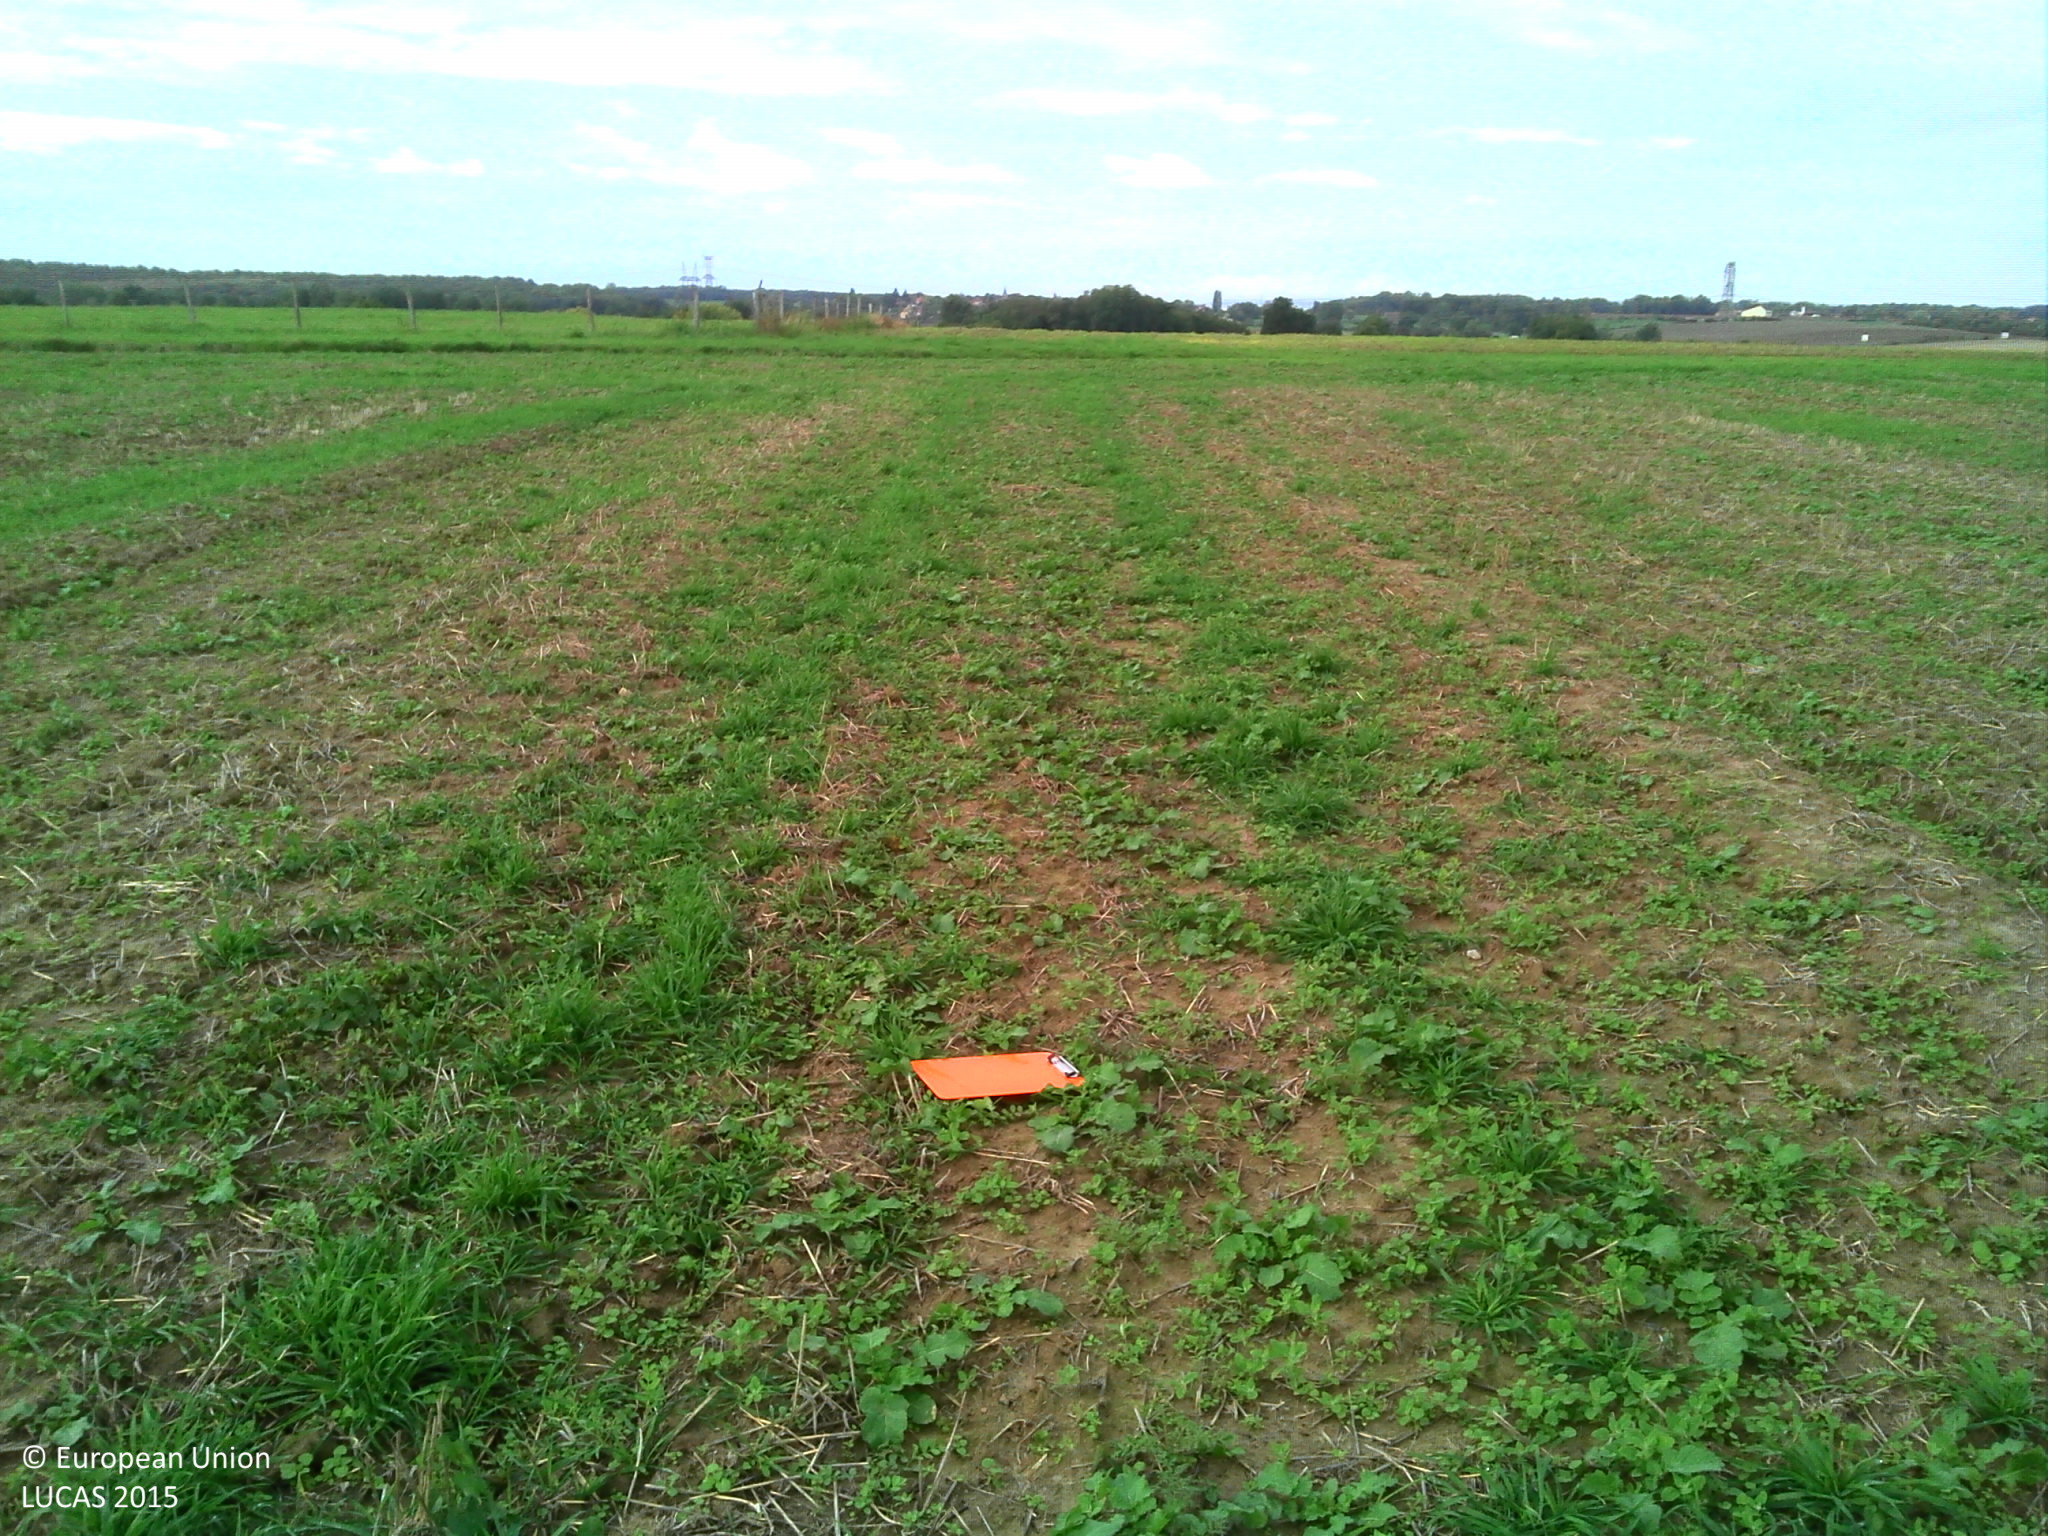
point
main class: Grassland
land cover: Spontaneously vegetated surfaces
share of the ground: 50 - 75 %
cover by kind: herbaceous plants 80 %, unconsolidated bare surface 20 %
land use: Agriculture (excluding fallow land and kitchen gardens)
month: October
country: FR
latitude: 48.2178
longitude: 4.2499
